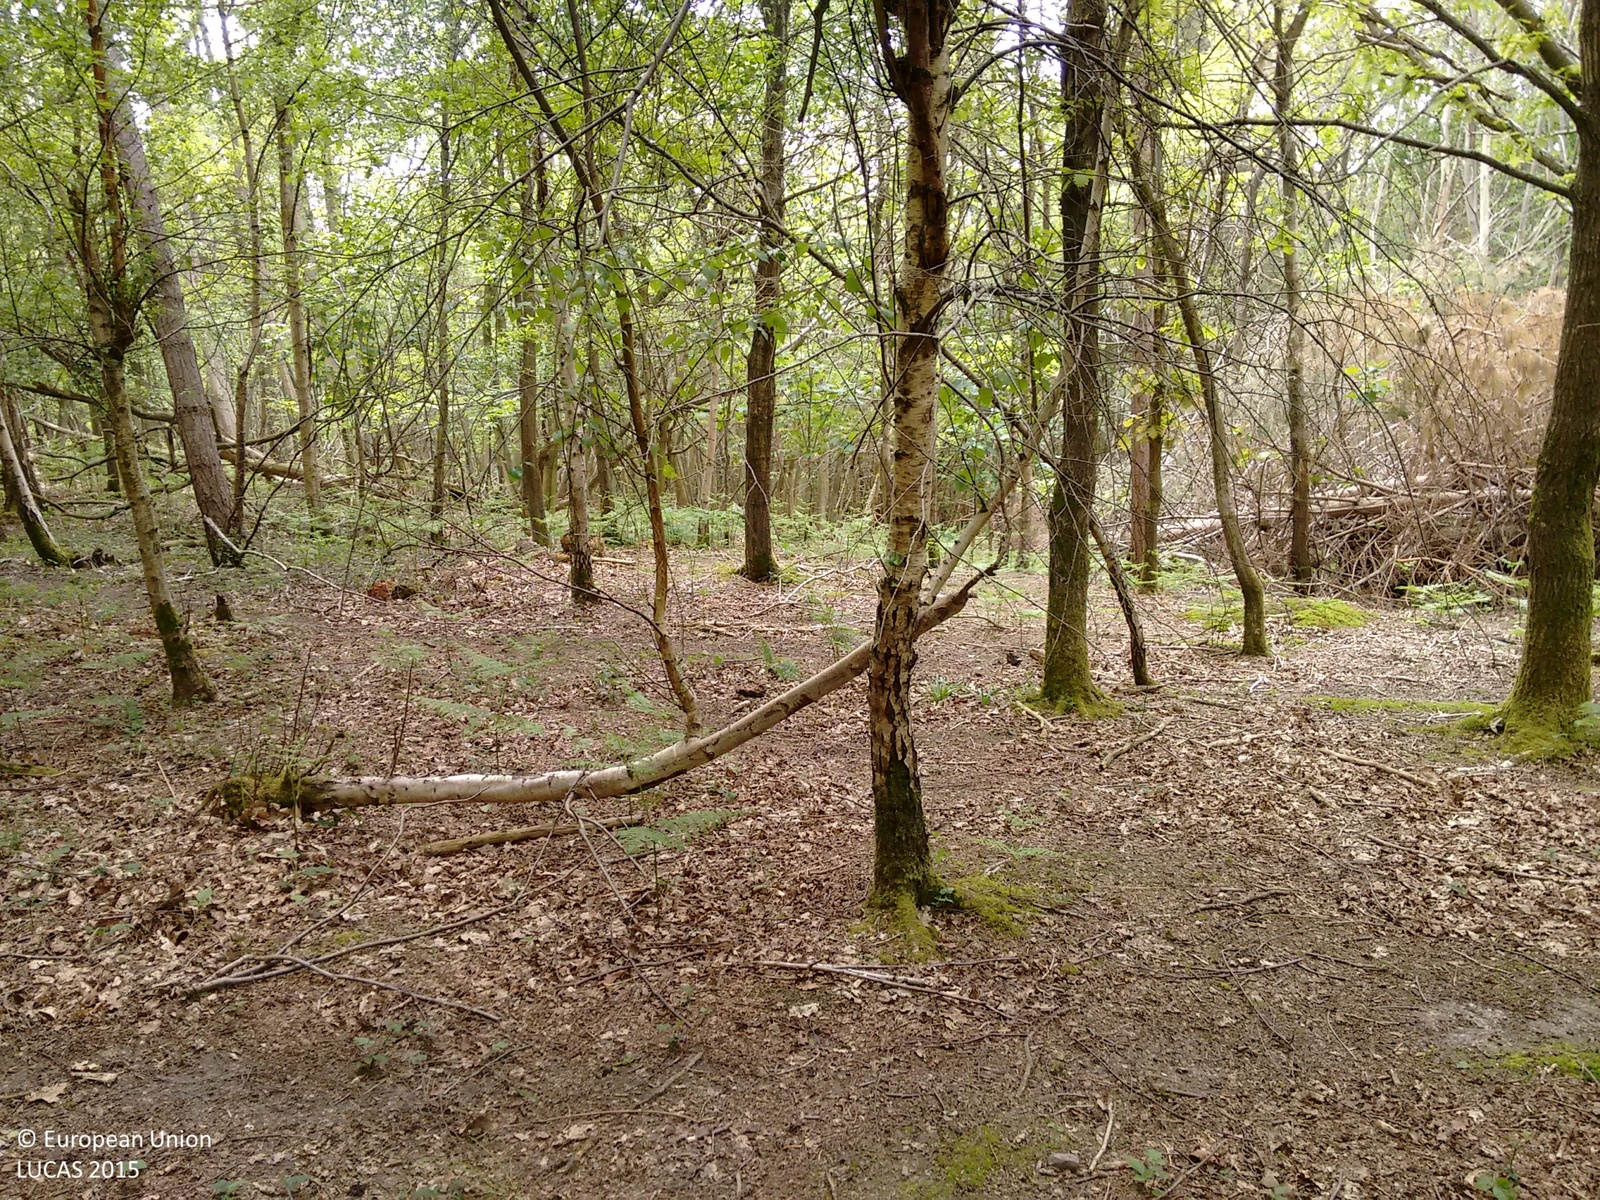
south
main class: Woodland
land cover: Broadleaved woodland
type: mesophytic deciduous forest
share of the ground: > 75 %
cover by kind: broadleaved forest trees 95 %, coniferous forest trees 5 %
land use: Forestry
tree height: > 5 m
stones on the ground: < 10 %
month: May
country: GB
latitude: 51.1125
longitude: 0.3286
